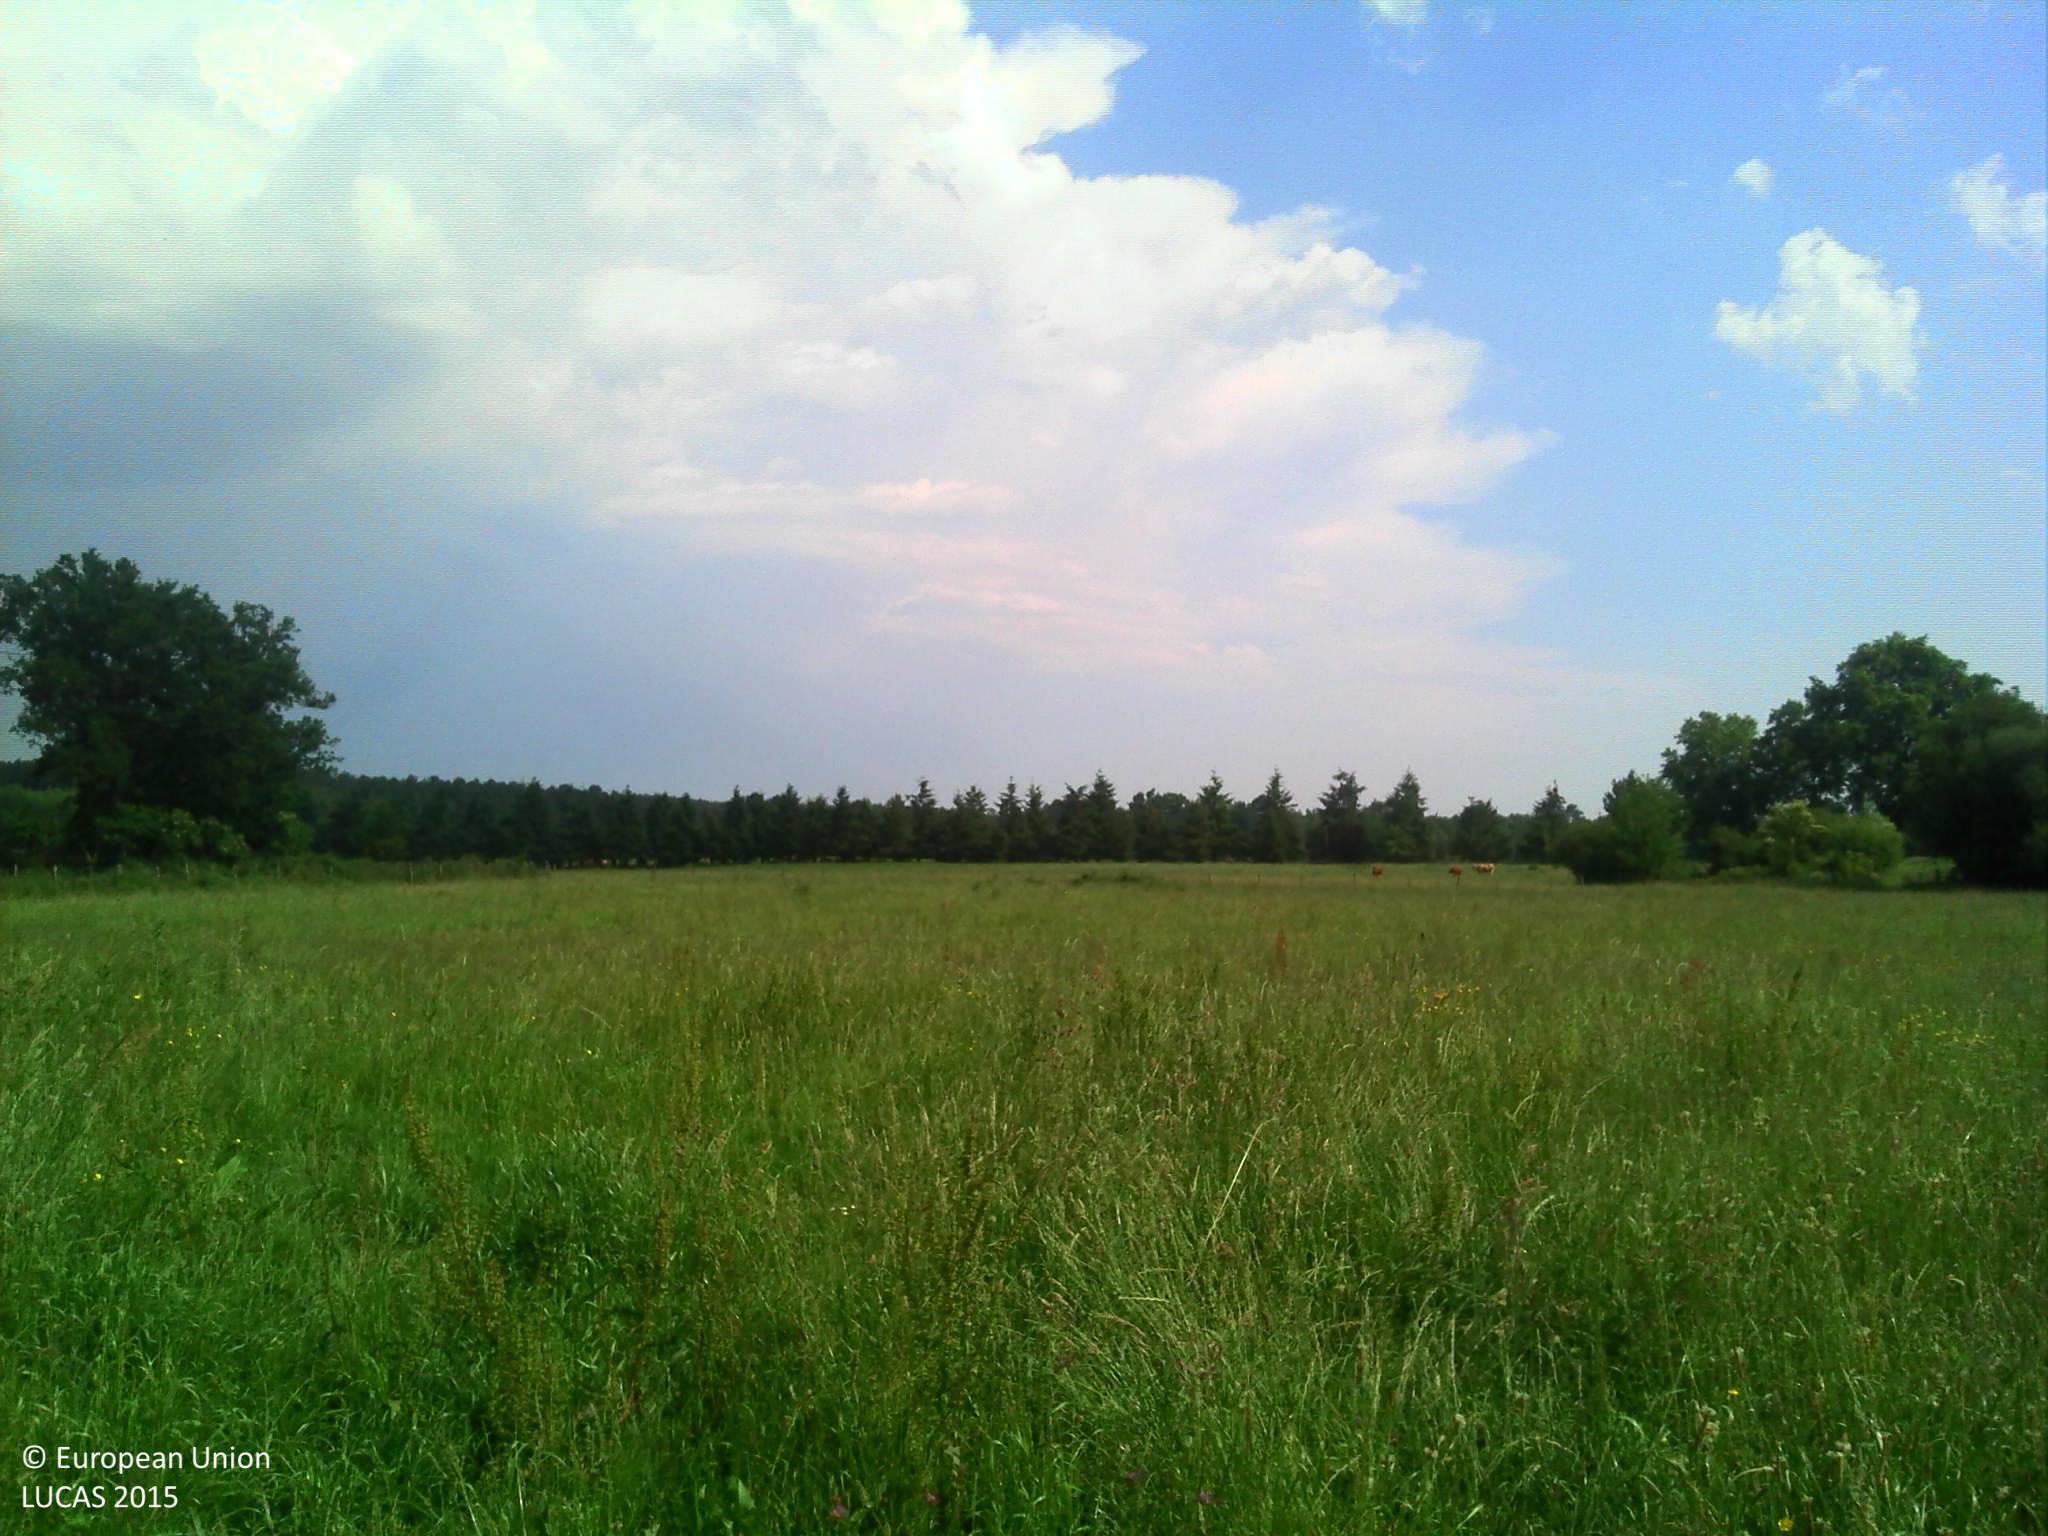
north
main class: Grassland
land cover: Grassland without tree/shrub cover
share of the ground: > 75 %
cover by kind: herbaceous plants 100 %
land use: Agriculture (excluding fallow land and kitchen gardens)
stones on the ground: < 10 %
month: June
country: FR
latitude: 47.8597
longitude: 0.0147
